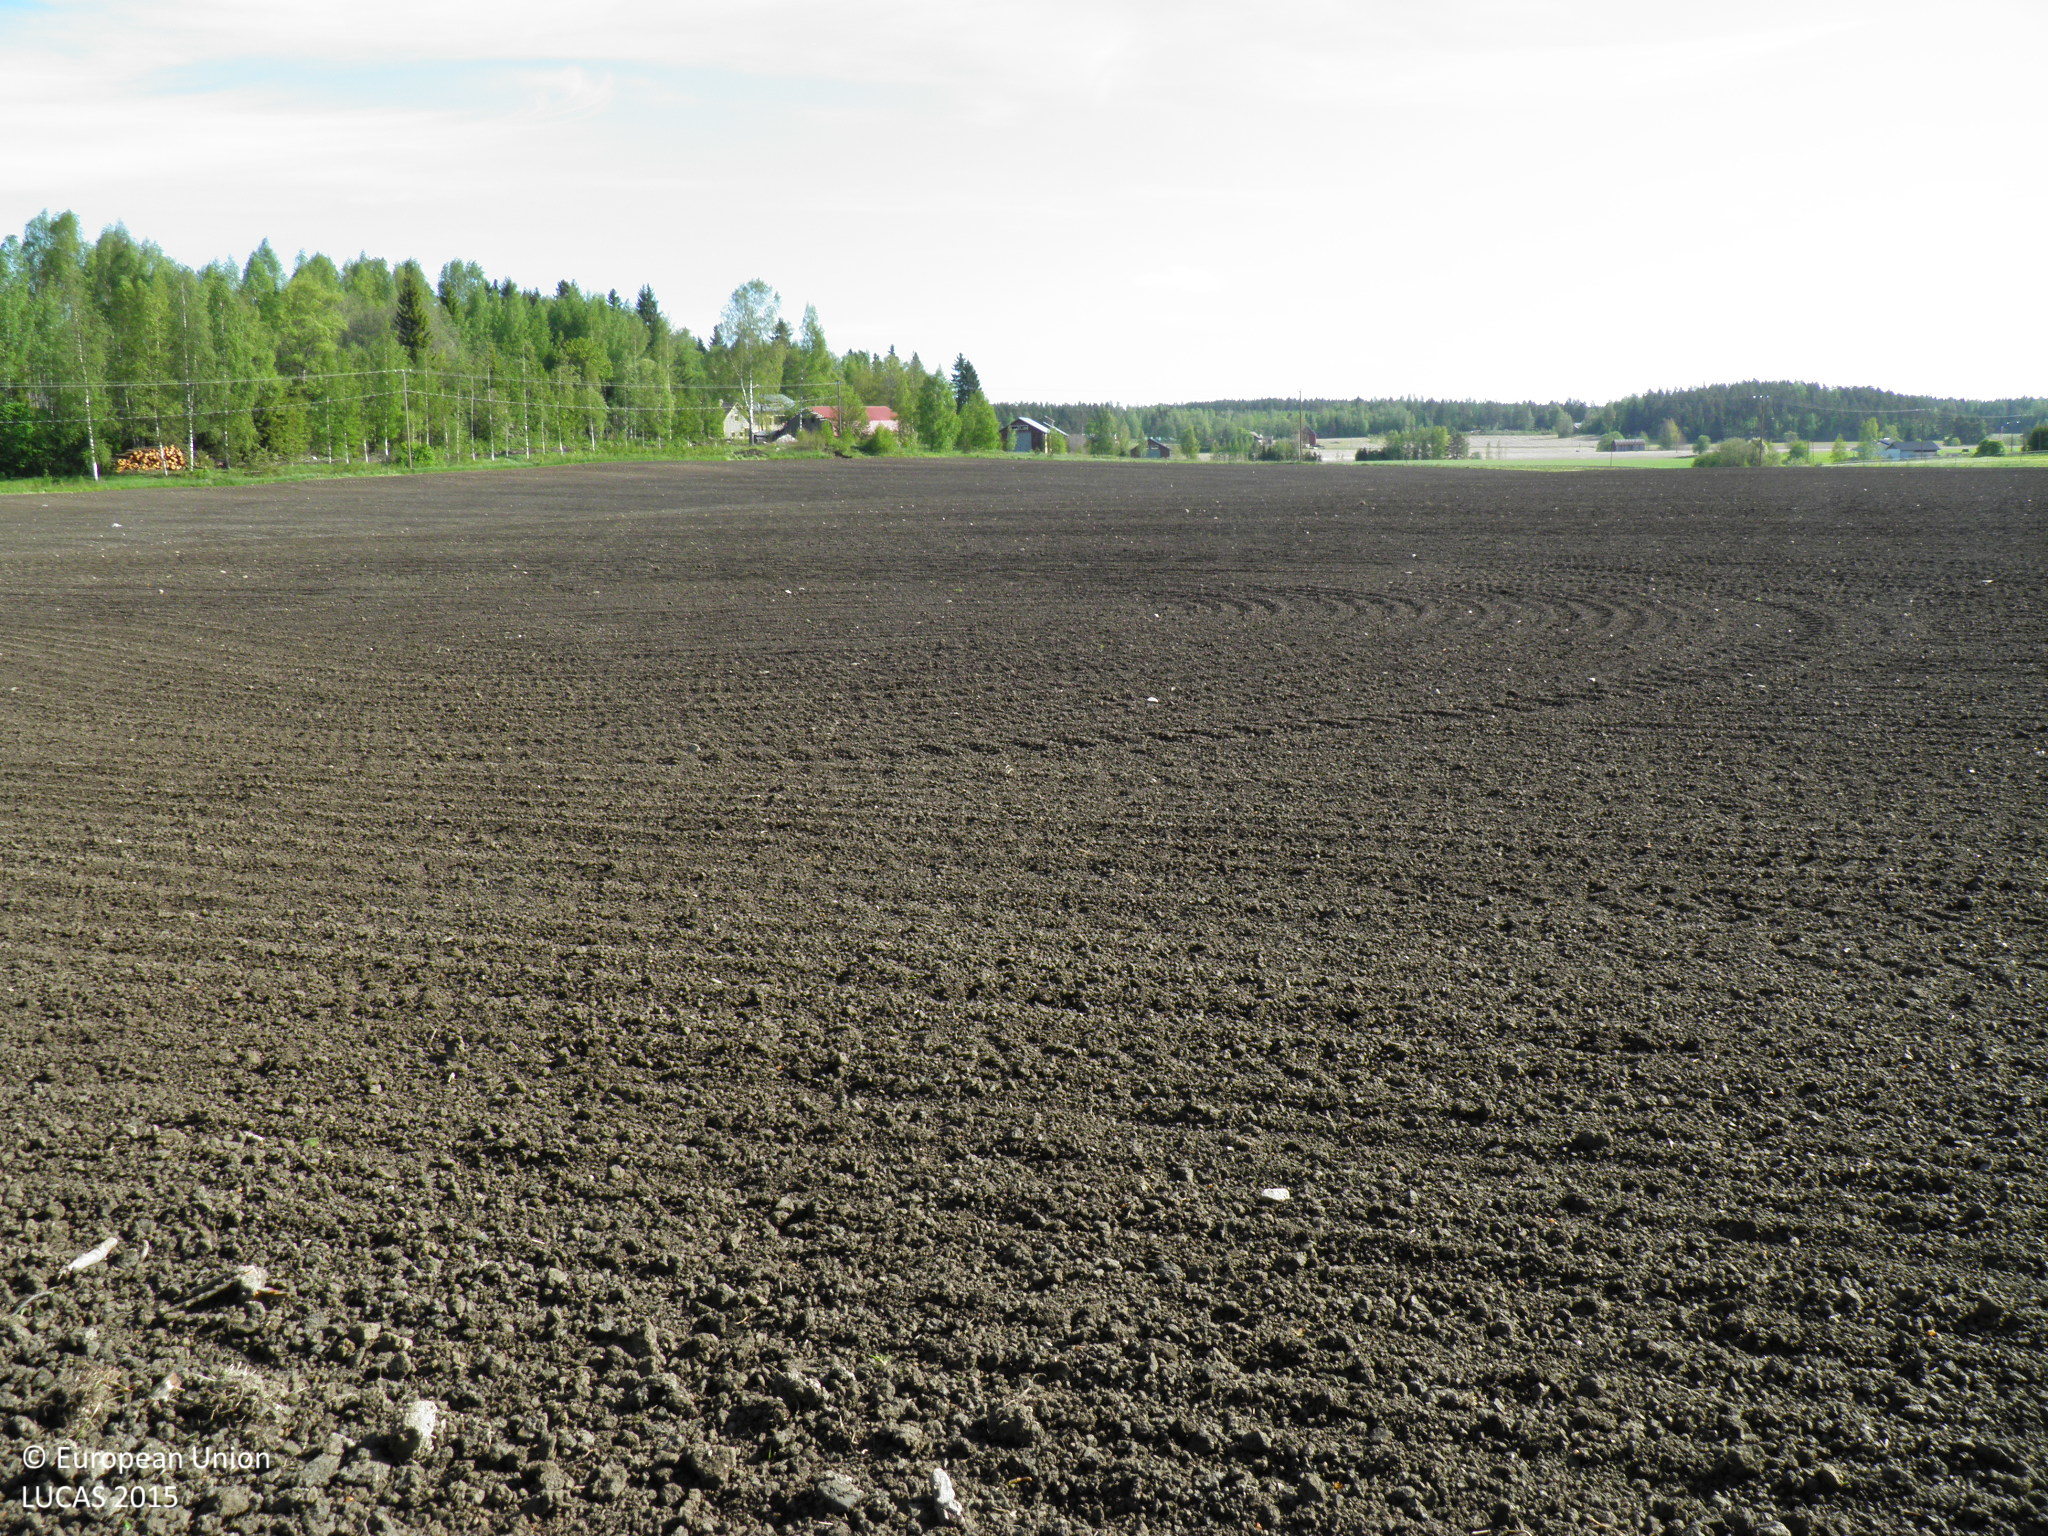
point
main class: Cropland
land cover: Common wheat
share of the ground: < 10 %
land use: Agriculture (excluding fallow land and kitchen gardens)
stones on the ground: < 10 %
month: June
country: FI
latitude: 60.5272
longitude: 22.5891
